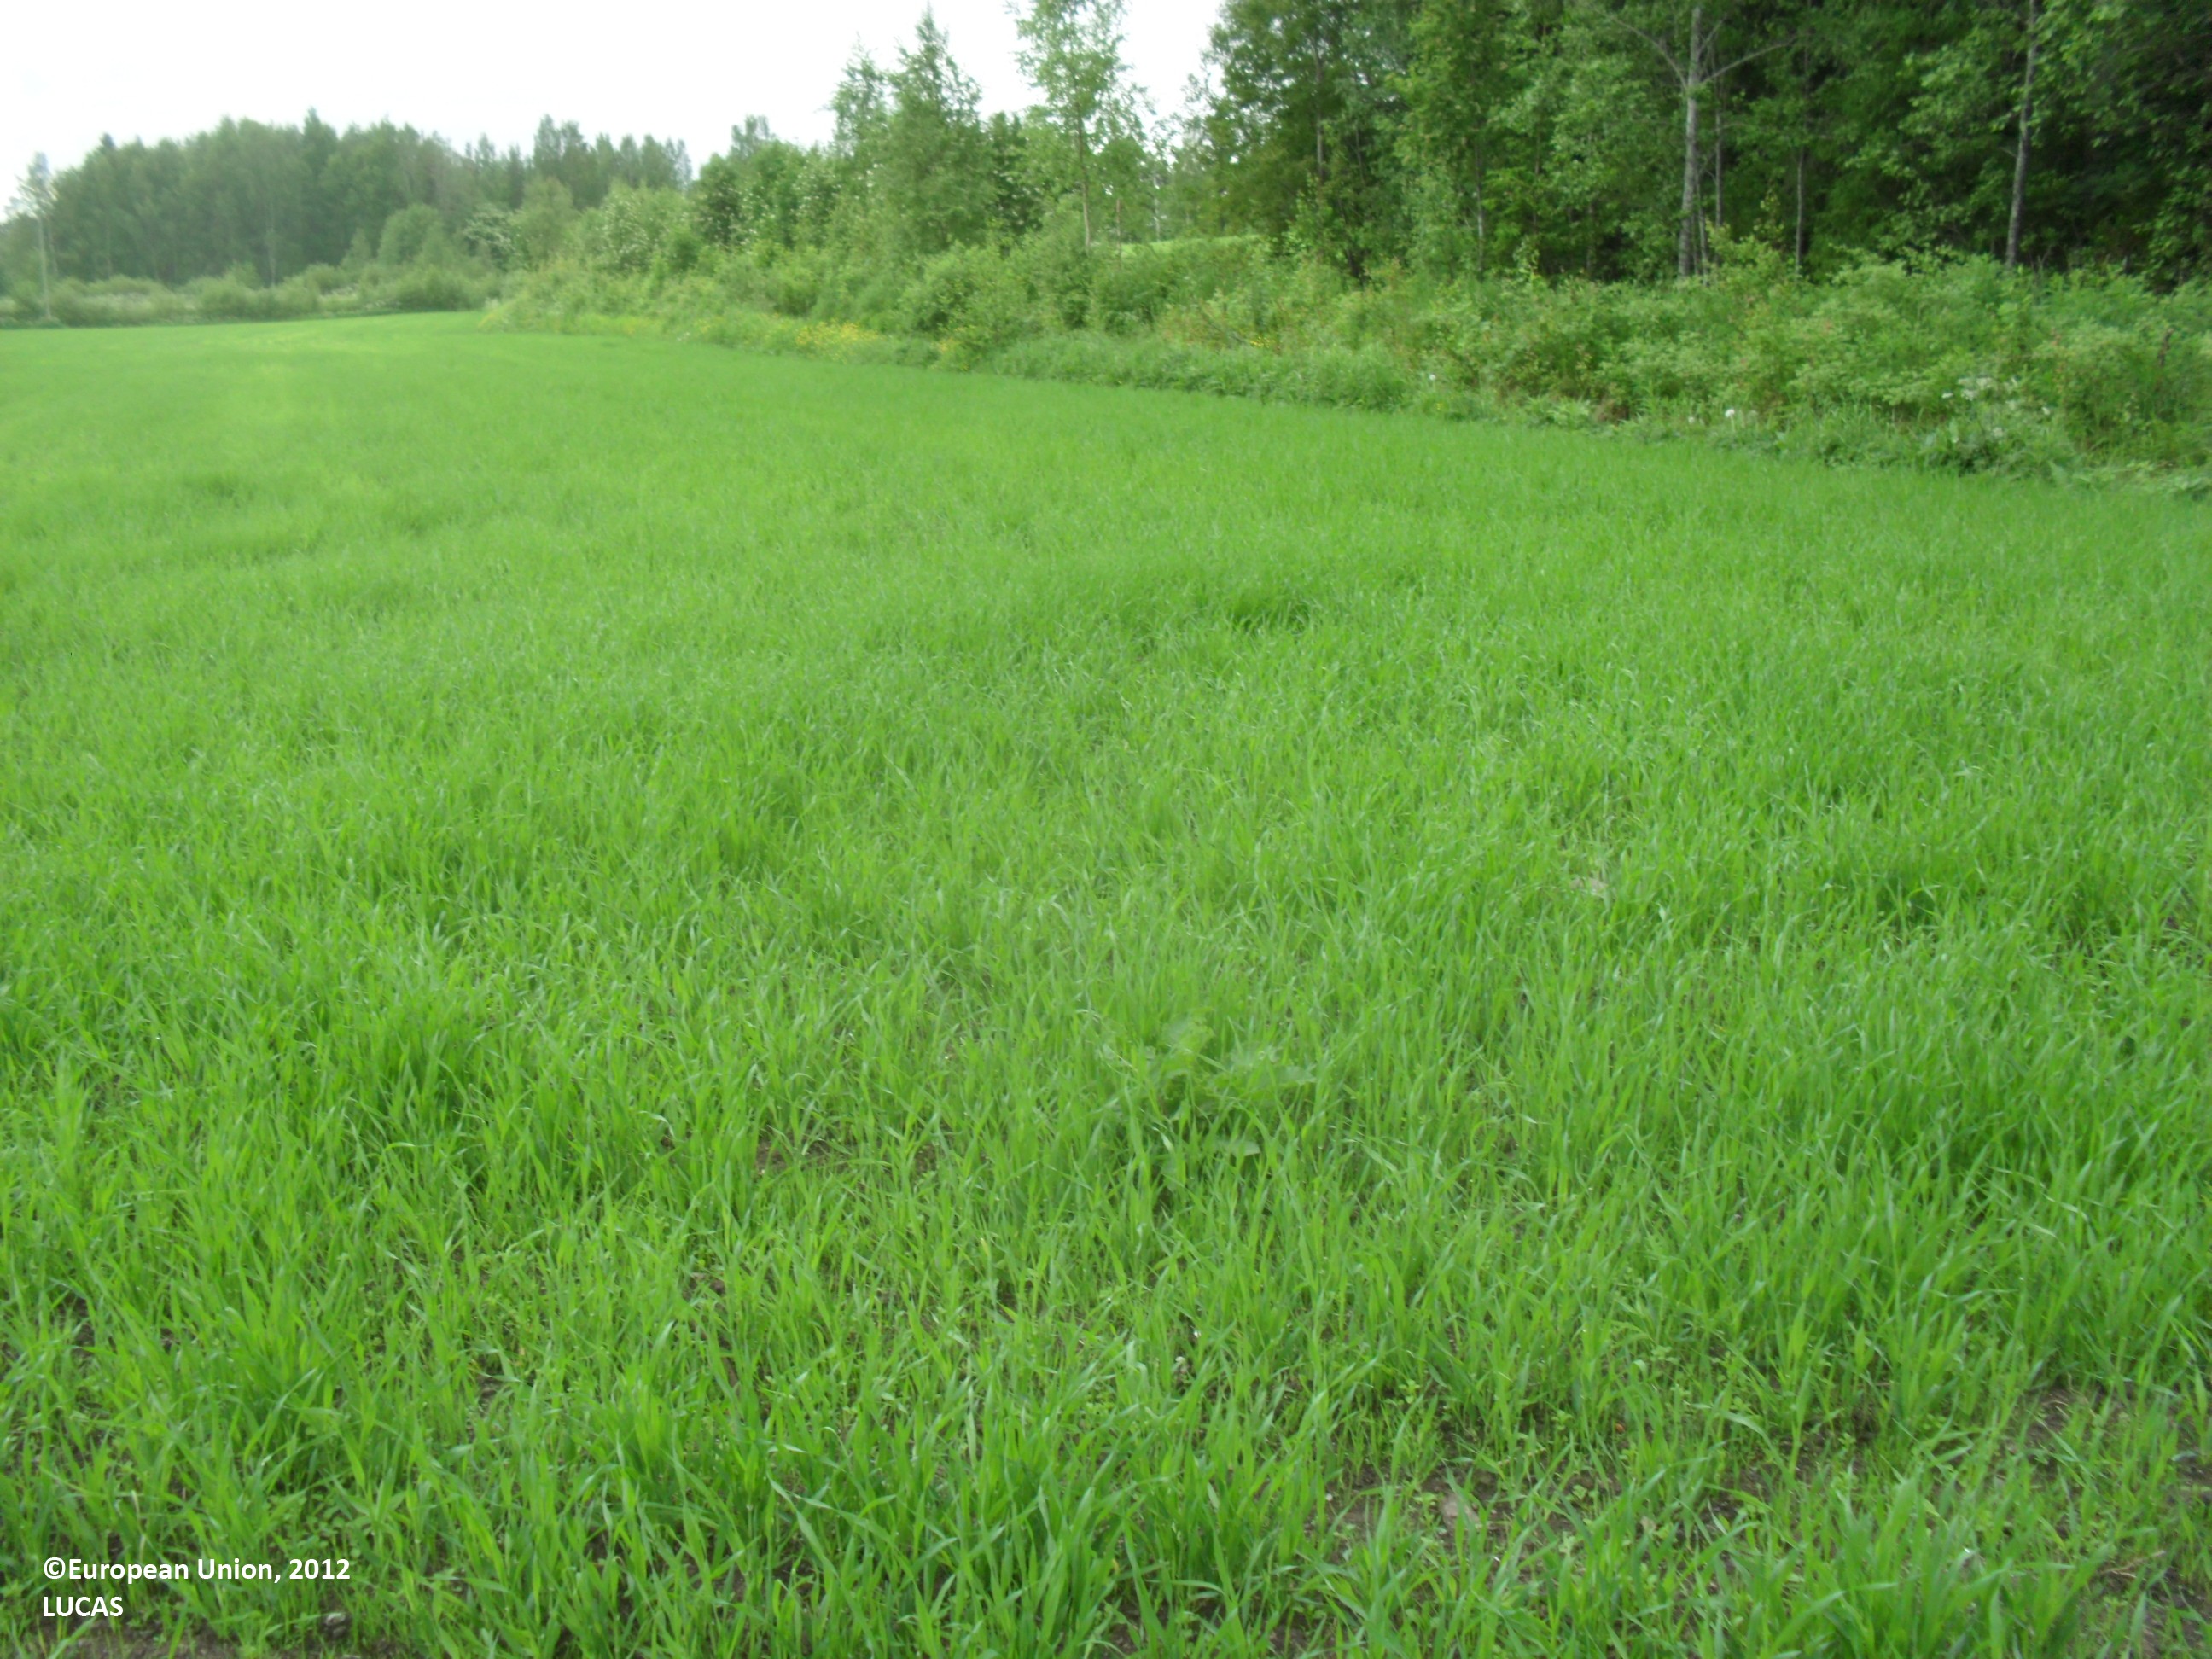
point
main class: Cropland
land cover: Barley
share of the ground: 25 - 50 %
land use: Agriculture (excluding fallow land and kitchen gardens)
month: June
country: FI
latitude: 63.3535
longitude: 23.3514
